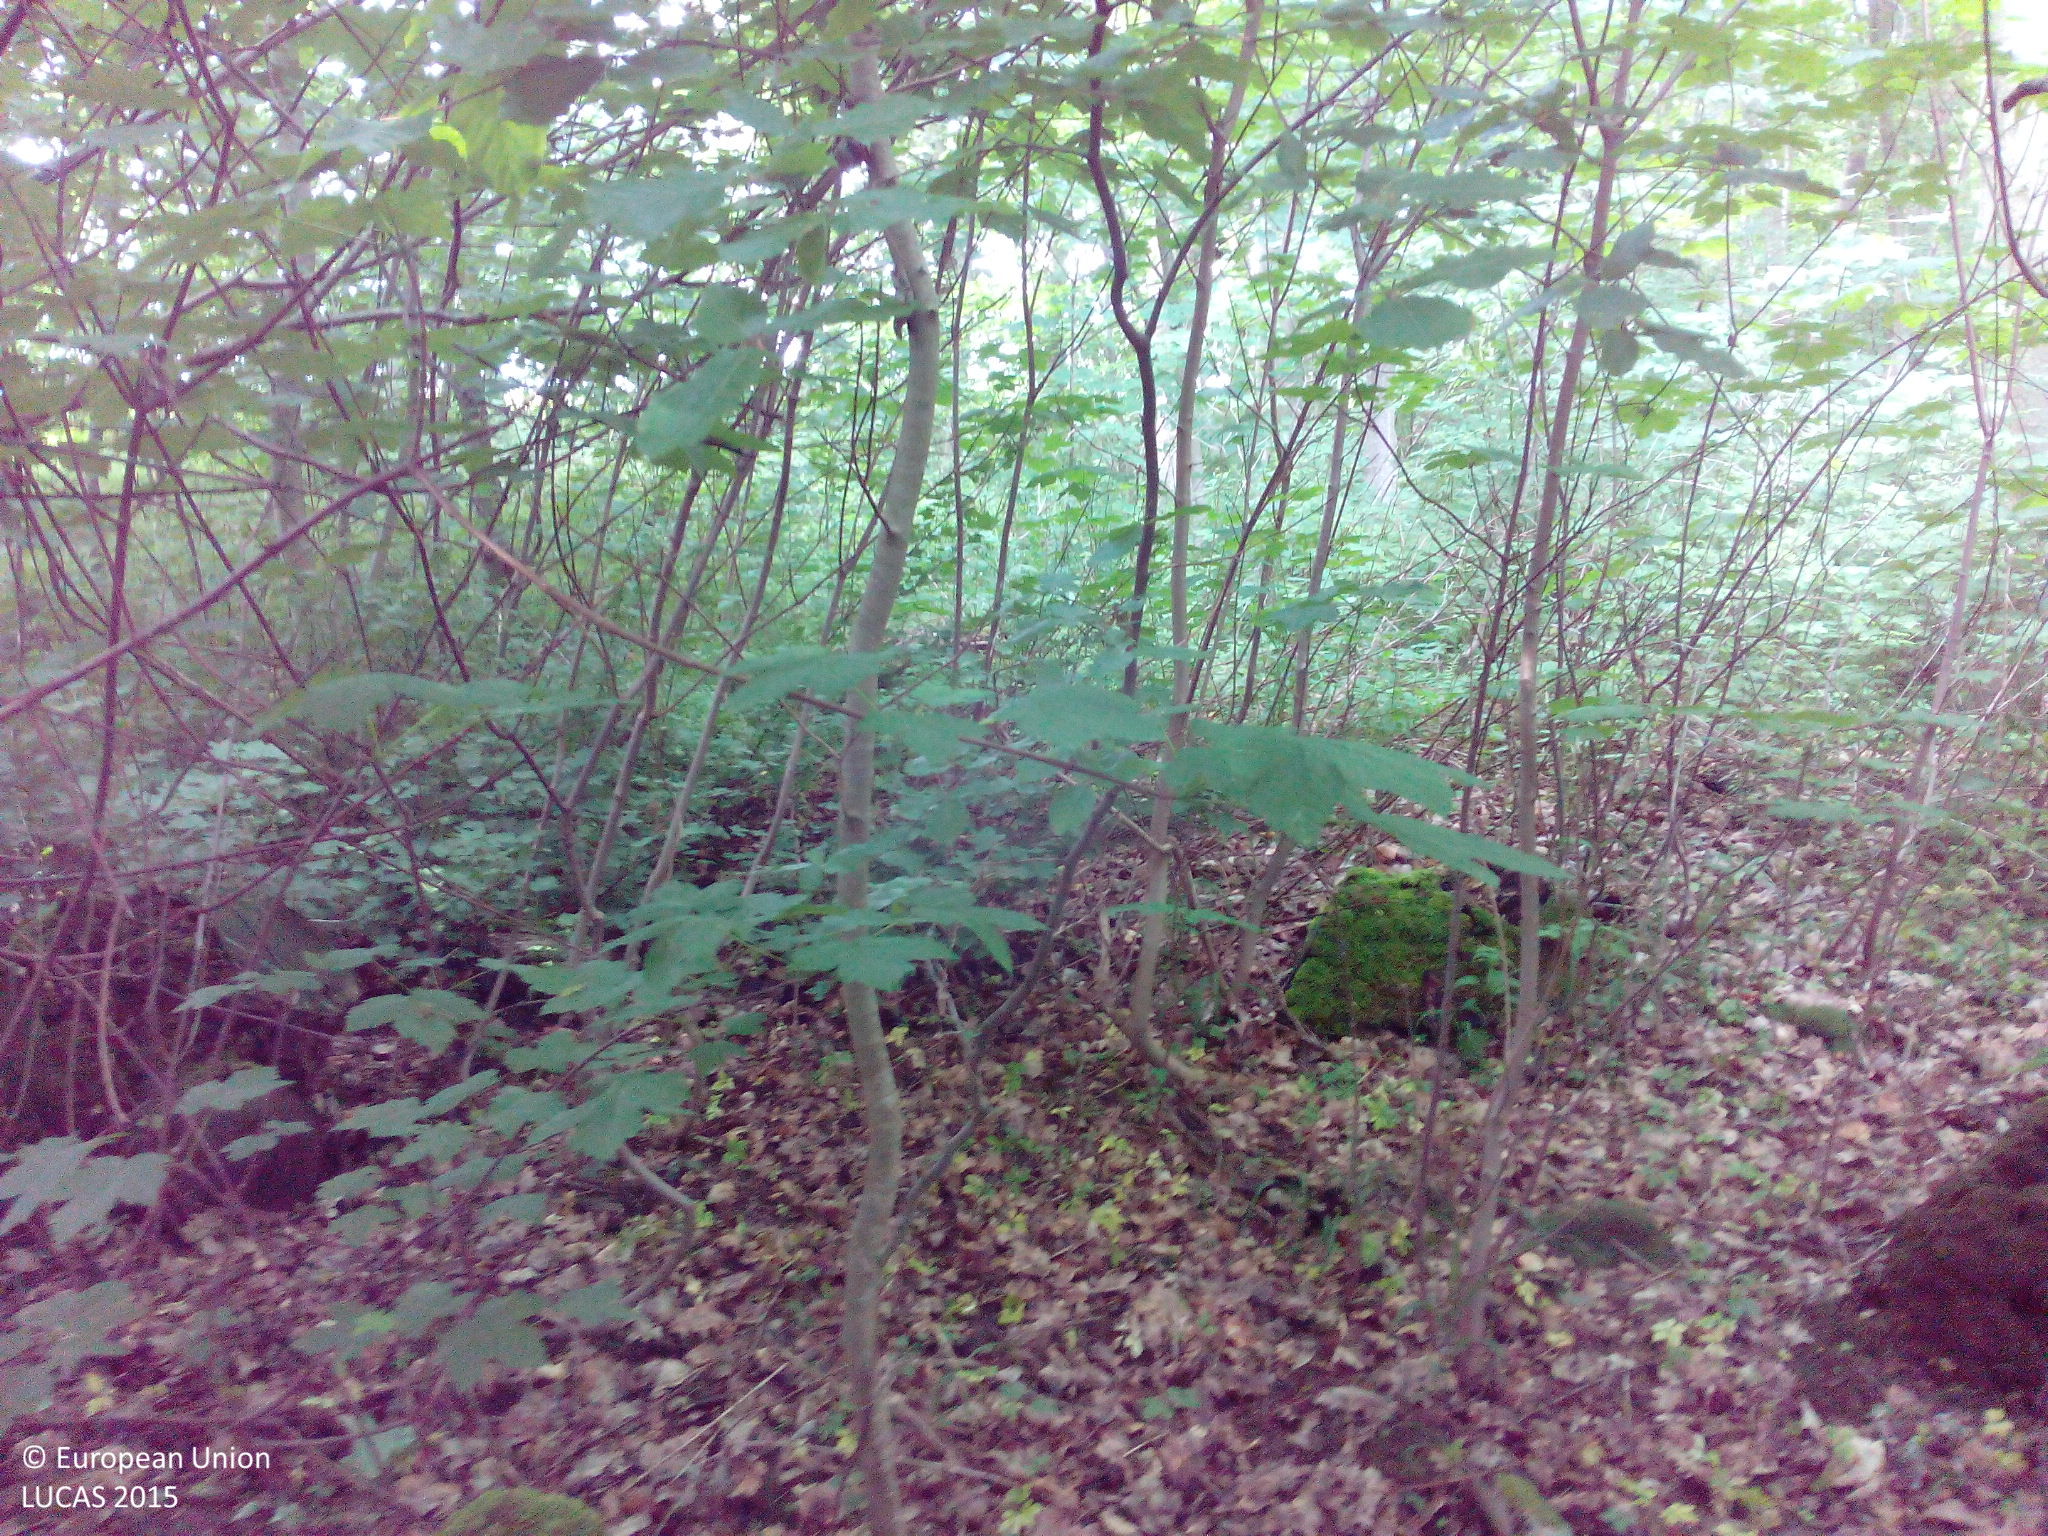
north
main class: Woodland
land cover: Broadleaved woodland
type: beech forest
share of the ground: > 75 %
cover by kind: broadleaved forest trees 100 %
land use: Forestry
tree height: > 5 m
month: June
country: DK
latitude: 54.8496
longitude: 11.4163
